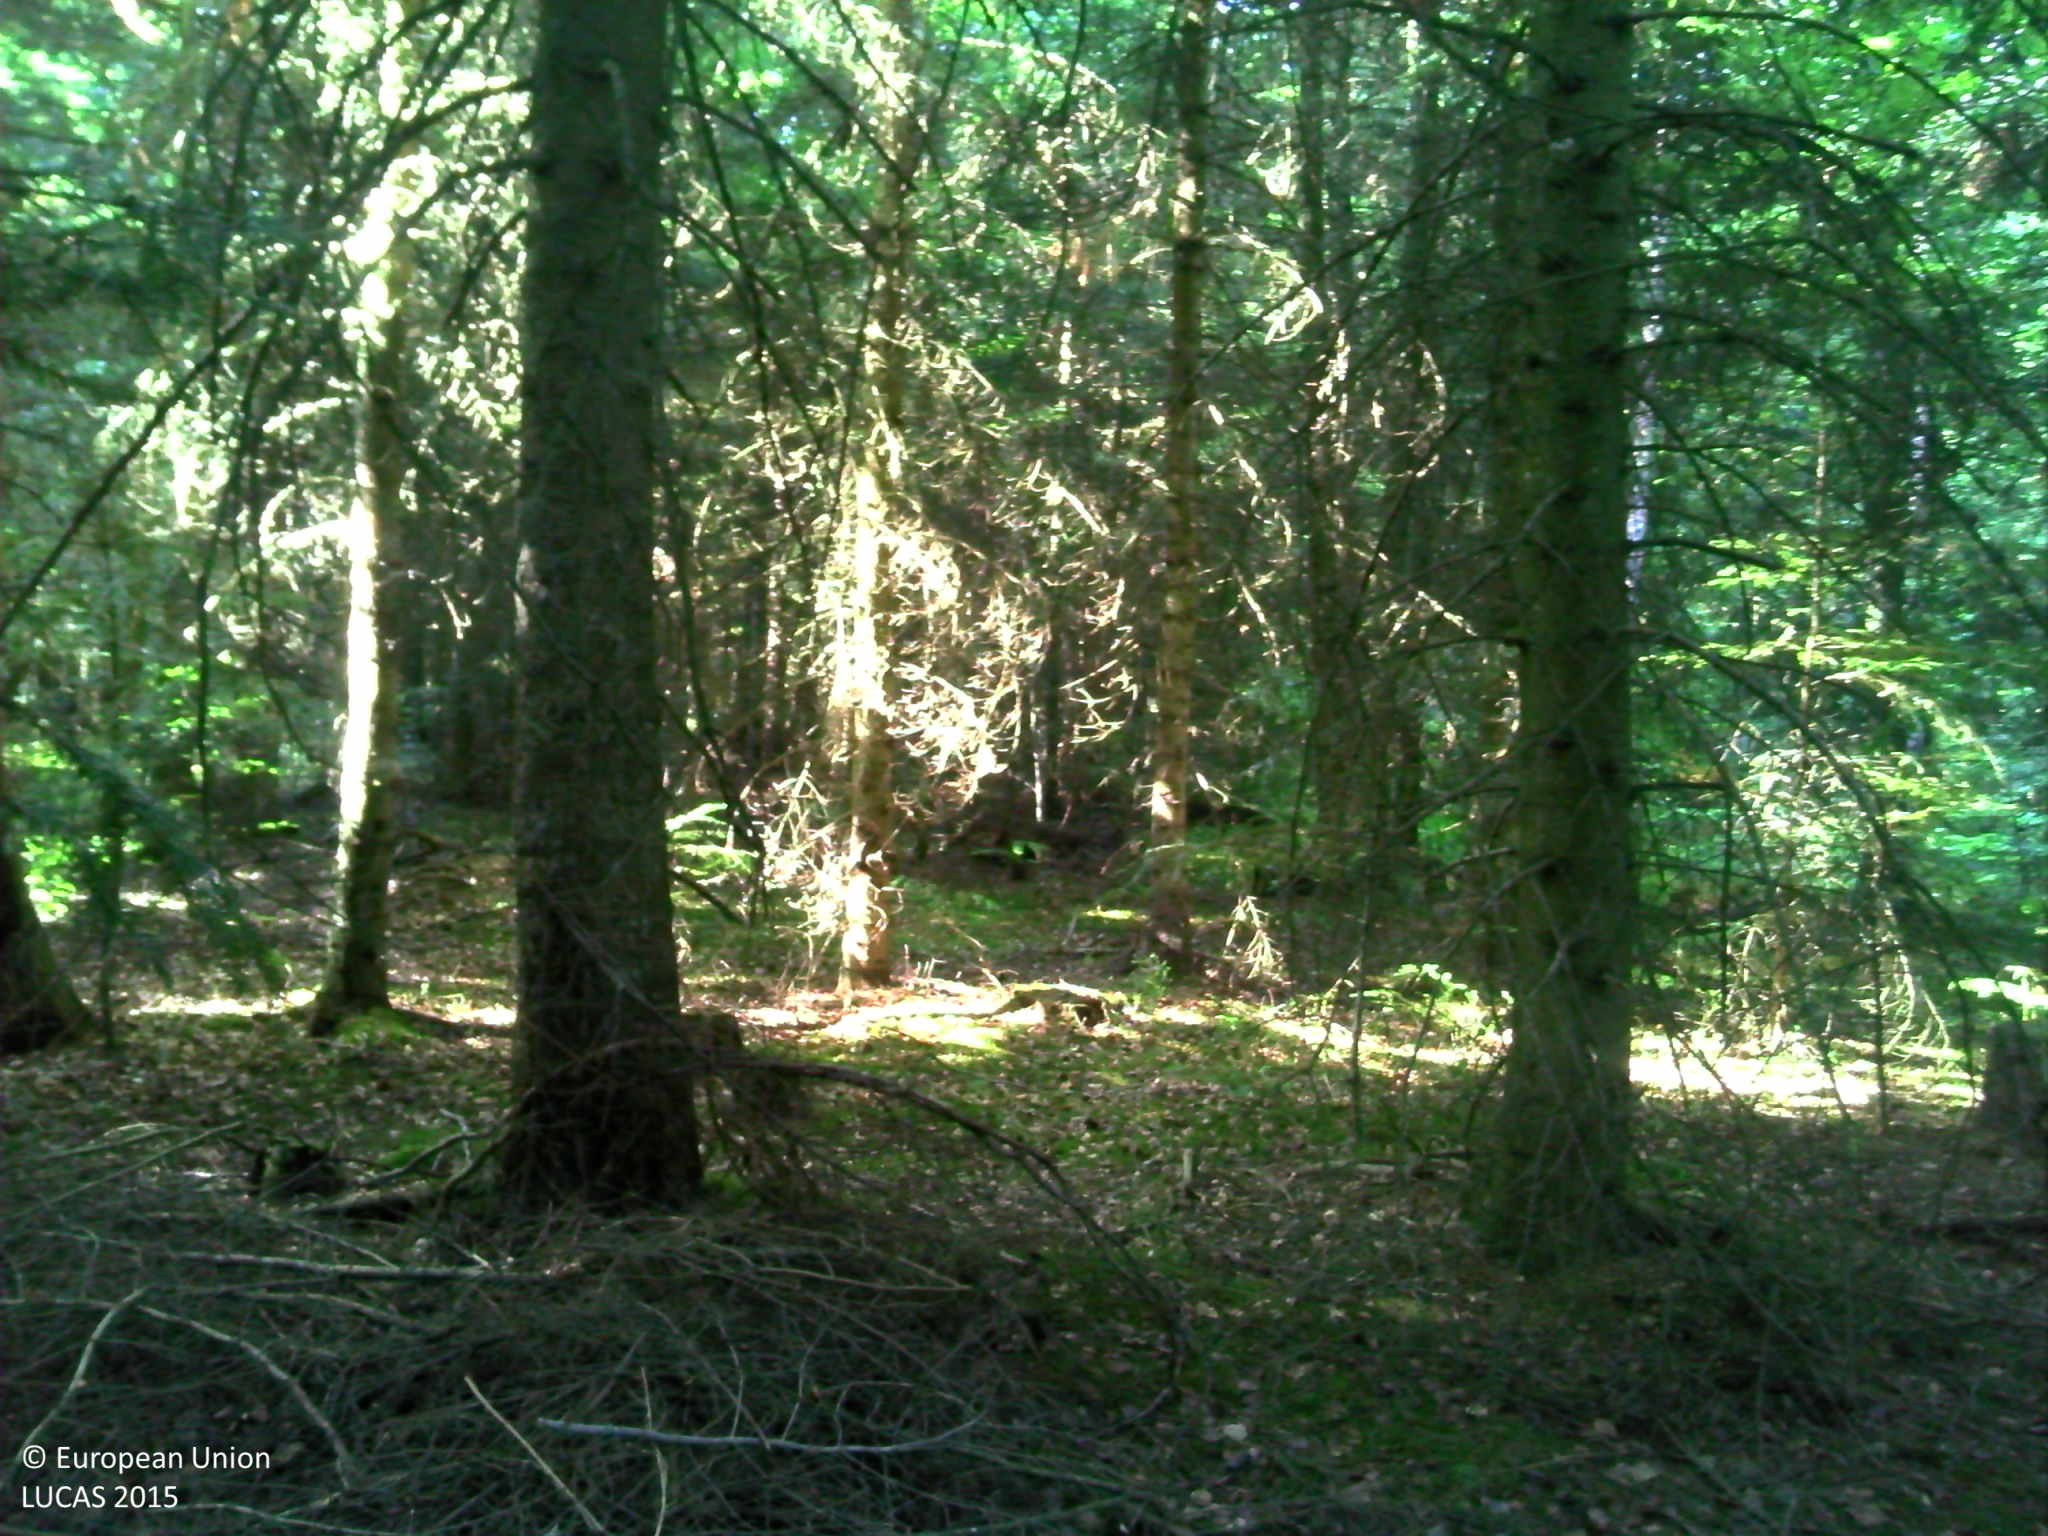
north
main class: Woodland
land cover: Other coniferous woodland
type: alpine coniferous forest
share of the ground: > 75 %
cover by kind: coniferous forest trees 90 %, herbaceous plants 5 %, lichens and mosses 5 %
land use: Forestry
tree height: > 5 m
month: July
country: FR
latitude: 44.9965
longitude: 3.4960
